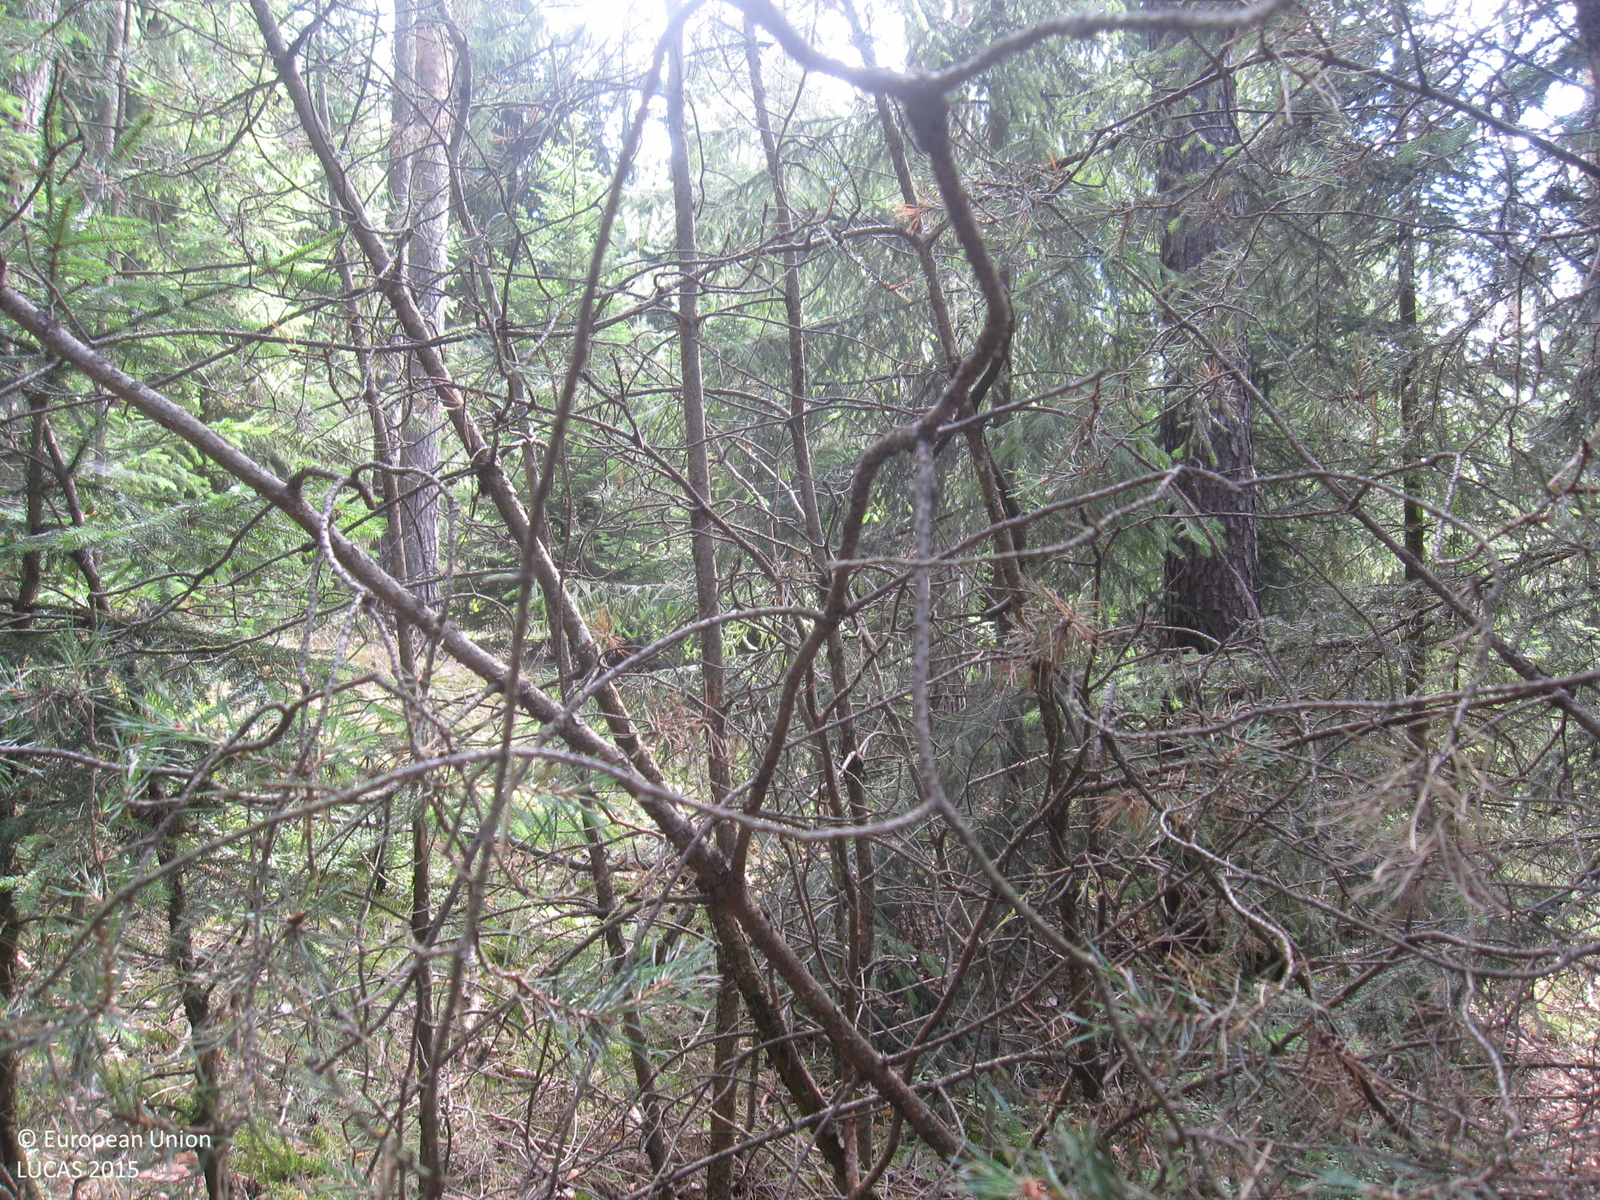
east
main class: Woodland
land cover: Pine dominated coniferous woodland
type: hemiboreal forest and nemoral coniferous forest and mixed broadleaved-coniferous forest
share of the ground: > 75 %
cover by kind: coniferous forest trees 85 %, lichens and mosses 10 %, unconsolidated bare surface 5 %
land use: Forestry
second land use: Amenities, museums, leisure
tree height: > 5 m
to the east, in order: Pine dominated coniferous woodland; Tracks; Pine dominated coniferous woodland; Fences; Spruce dominated coniferous woodland; Tracks; Fences; Spruce dominated mixed woodland; Fences; Spruce dominated mixed woodland
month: August
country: DE
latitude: 50.6145
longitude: 12.1054
